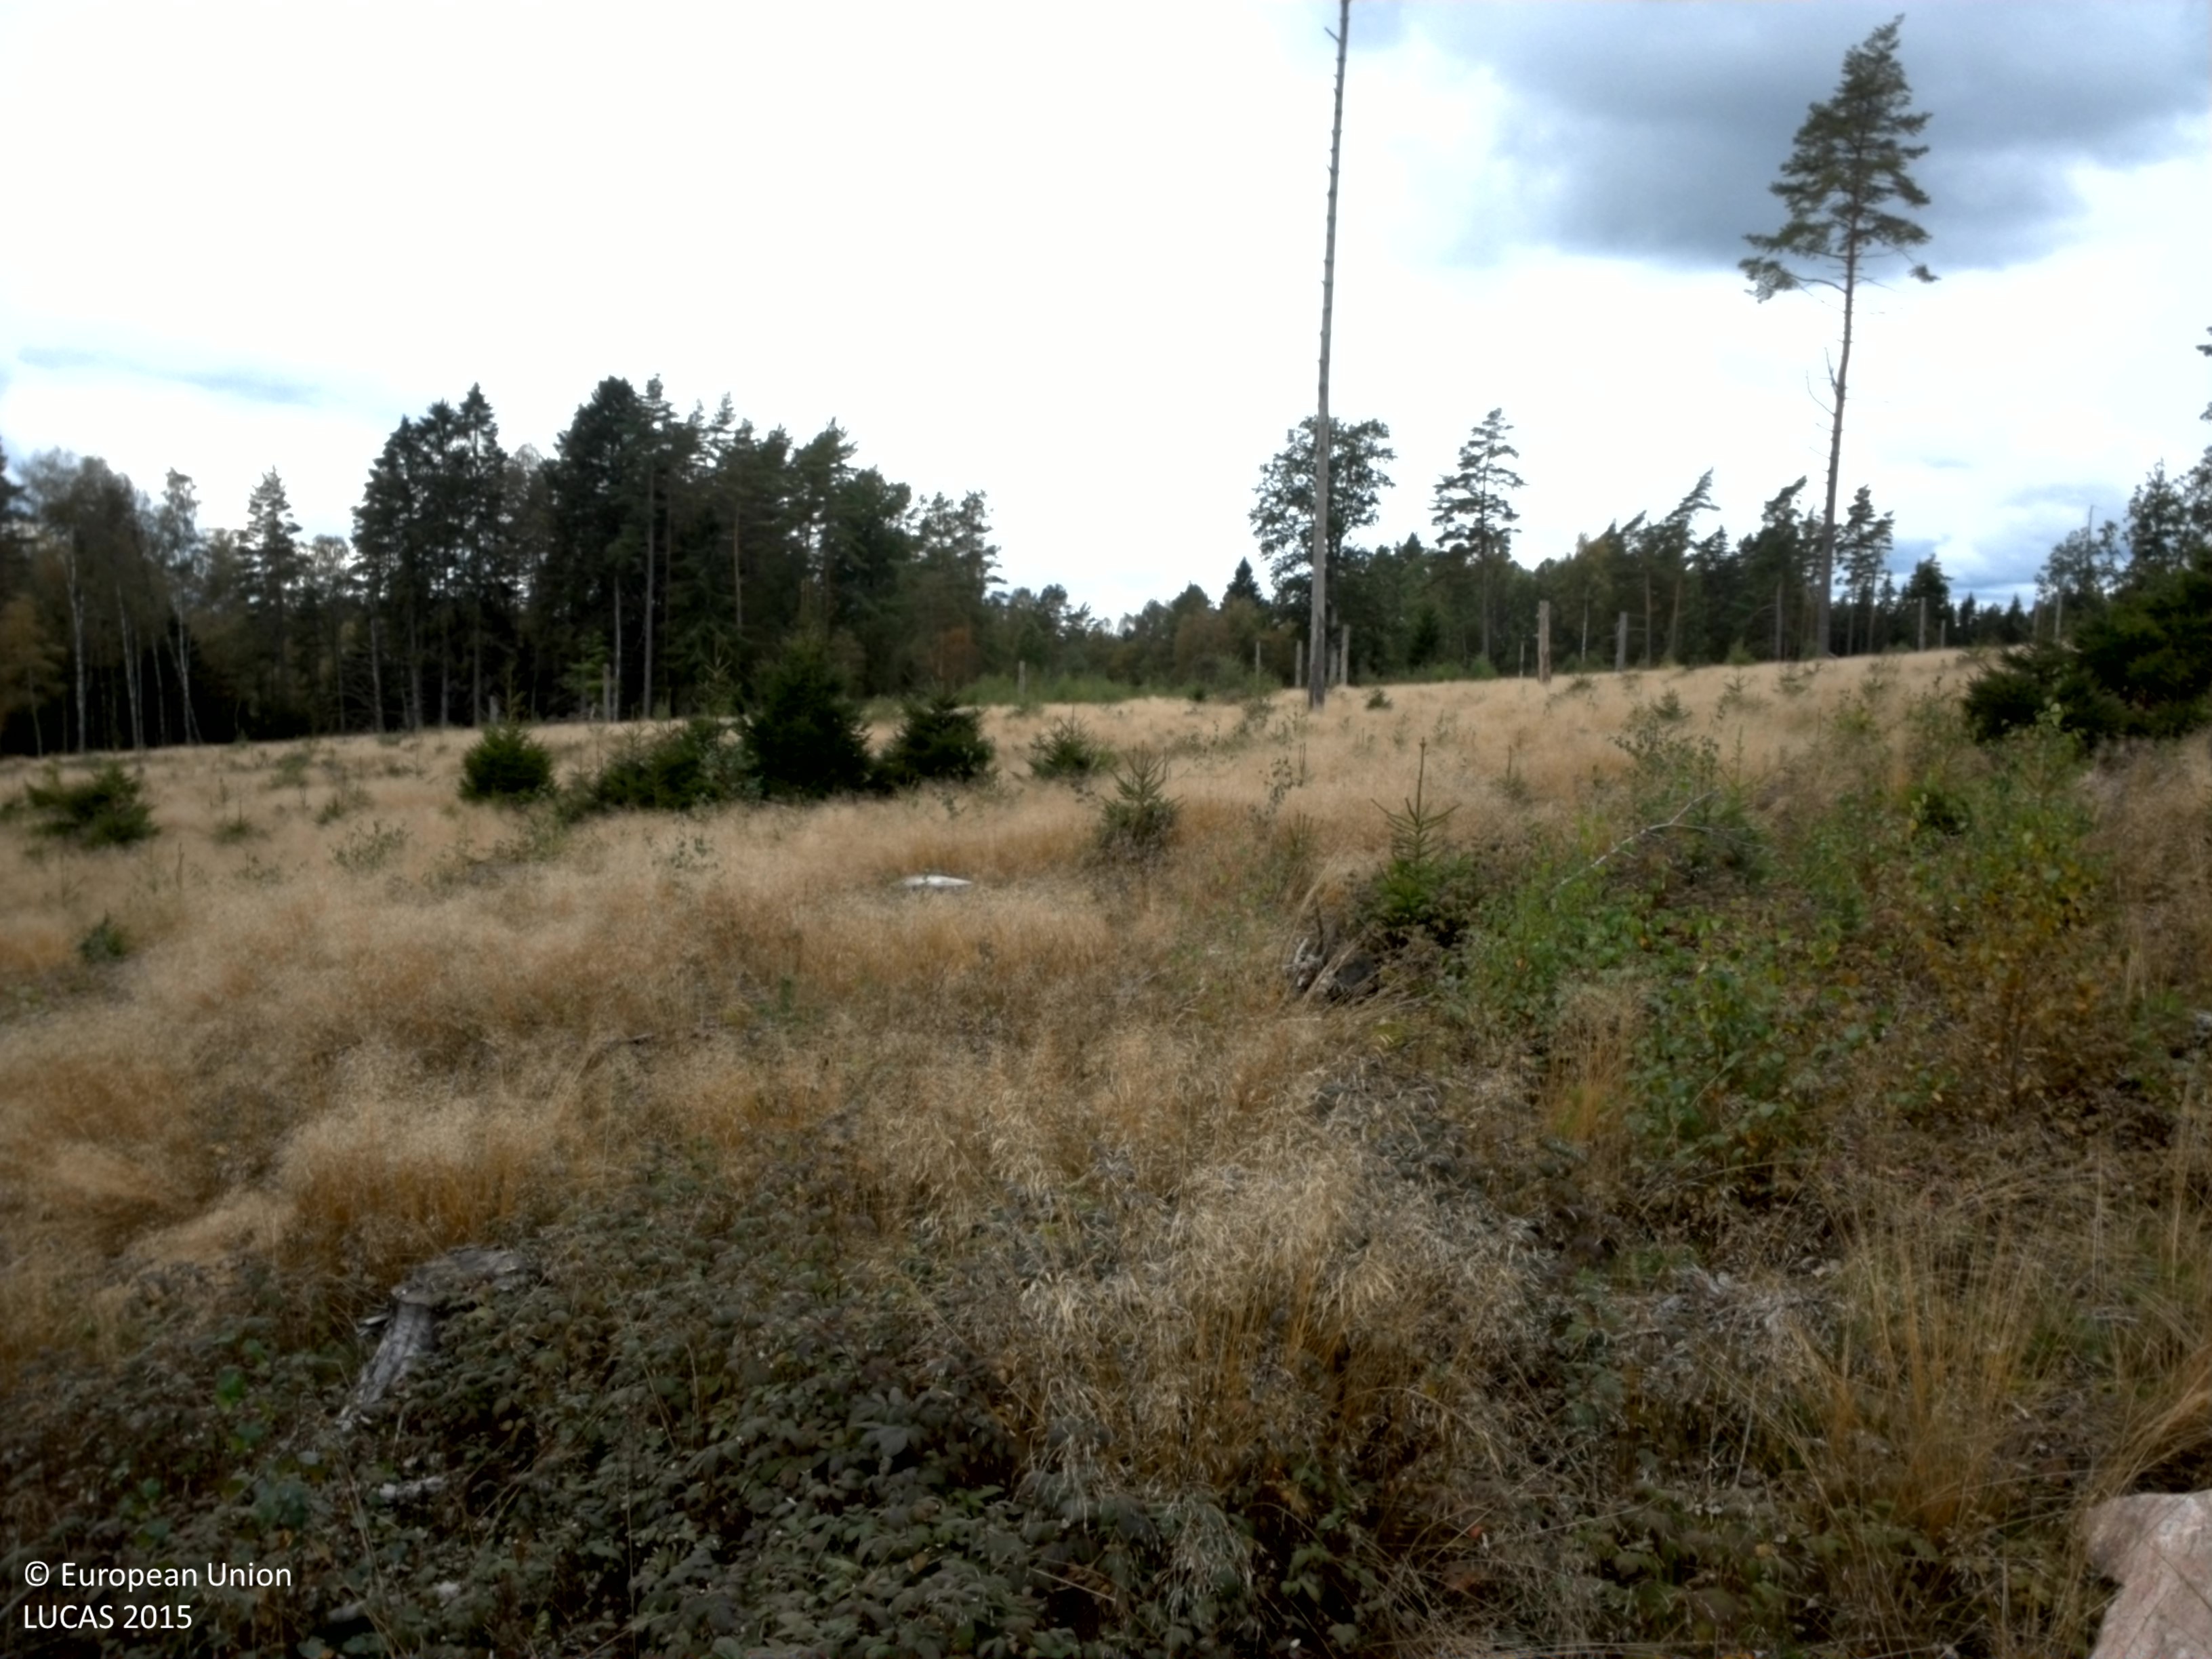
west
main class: Shrubland
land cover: Shrubland with sparse tree cover
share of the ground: 50 - 75 %
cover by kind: shrubs 75 %, herbaceous plants 15 %, coniferous forest trees 5 %, unconsolidated bare surface 5 %
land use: Forestry
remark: Clear cut
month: September
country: SE
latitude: 58.0048
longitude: 13.0579
